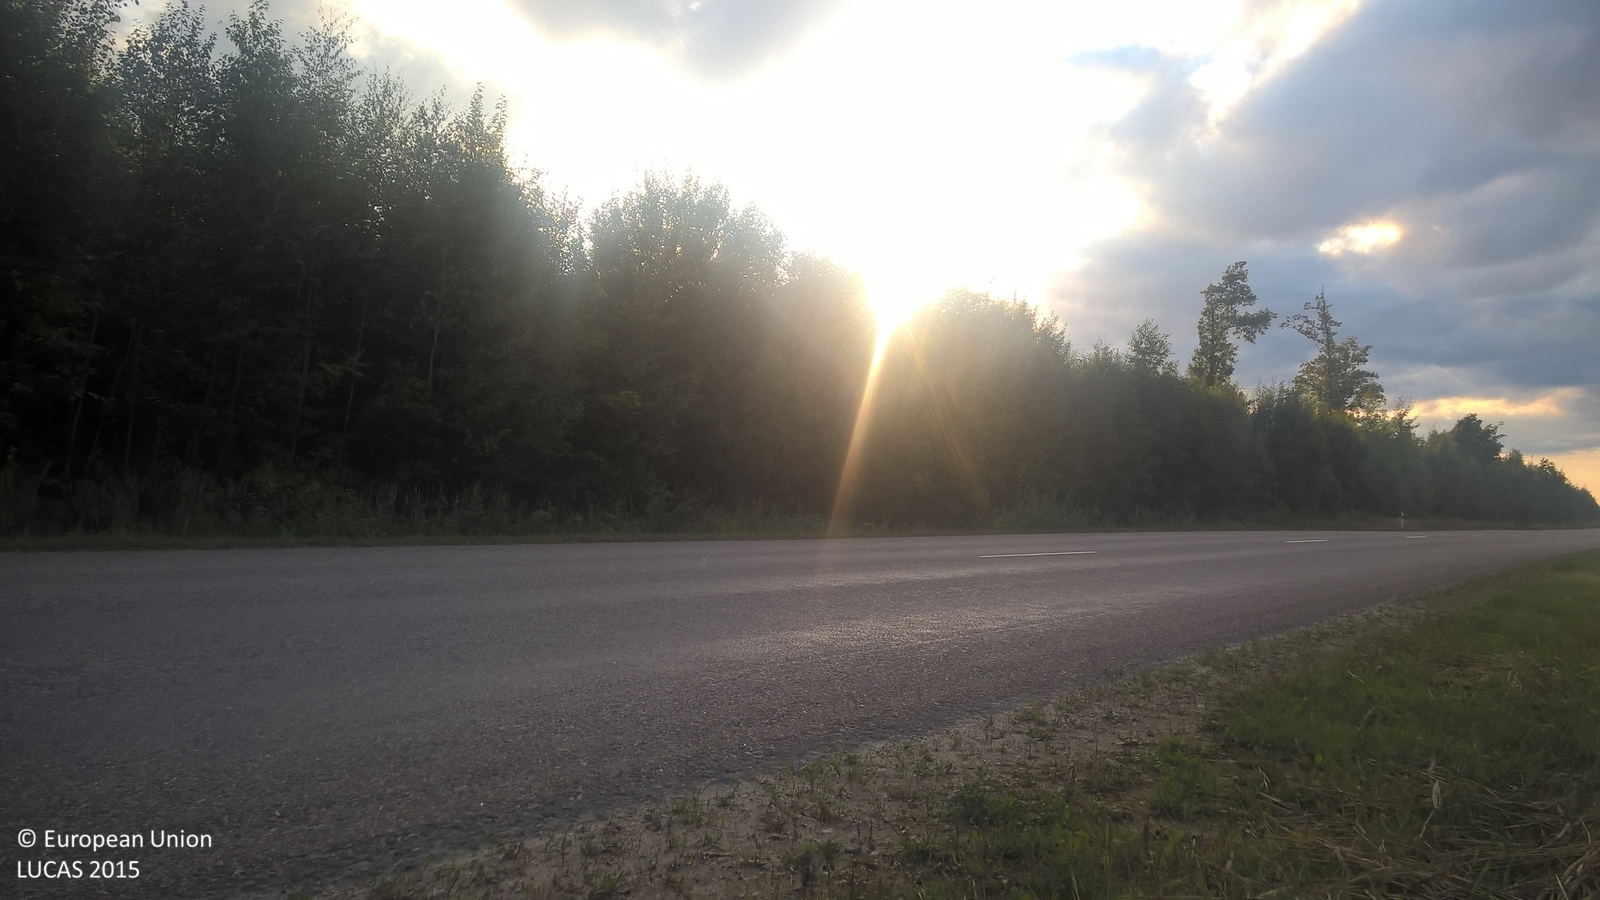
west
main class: Grassland
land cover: Grassland without tree/shrub cover
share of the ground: > 75 %
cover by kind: herbaceous plants 100 %
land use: Agriculture (excluding fallow land and kitchen gardens)
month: September
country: LV
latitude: 57.4822
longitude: 25.6129
